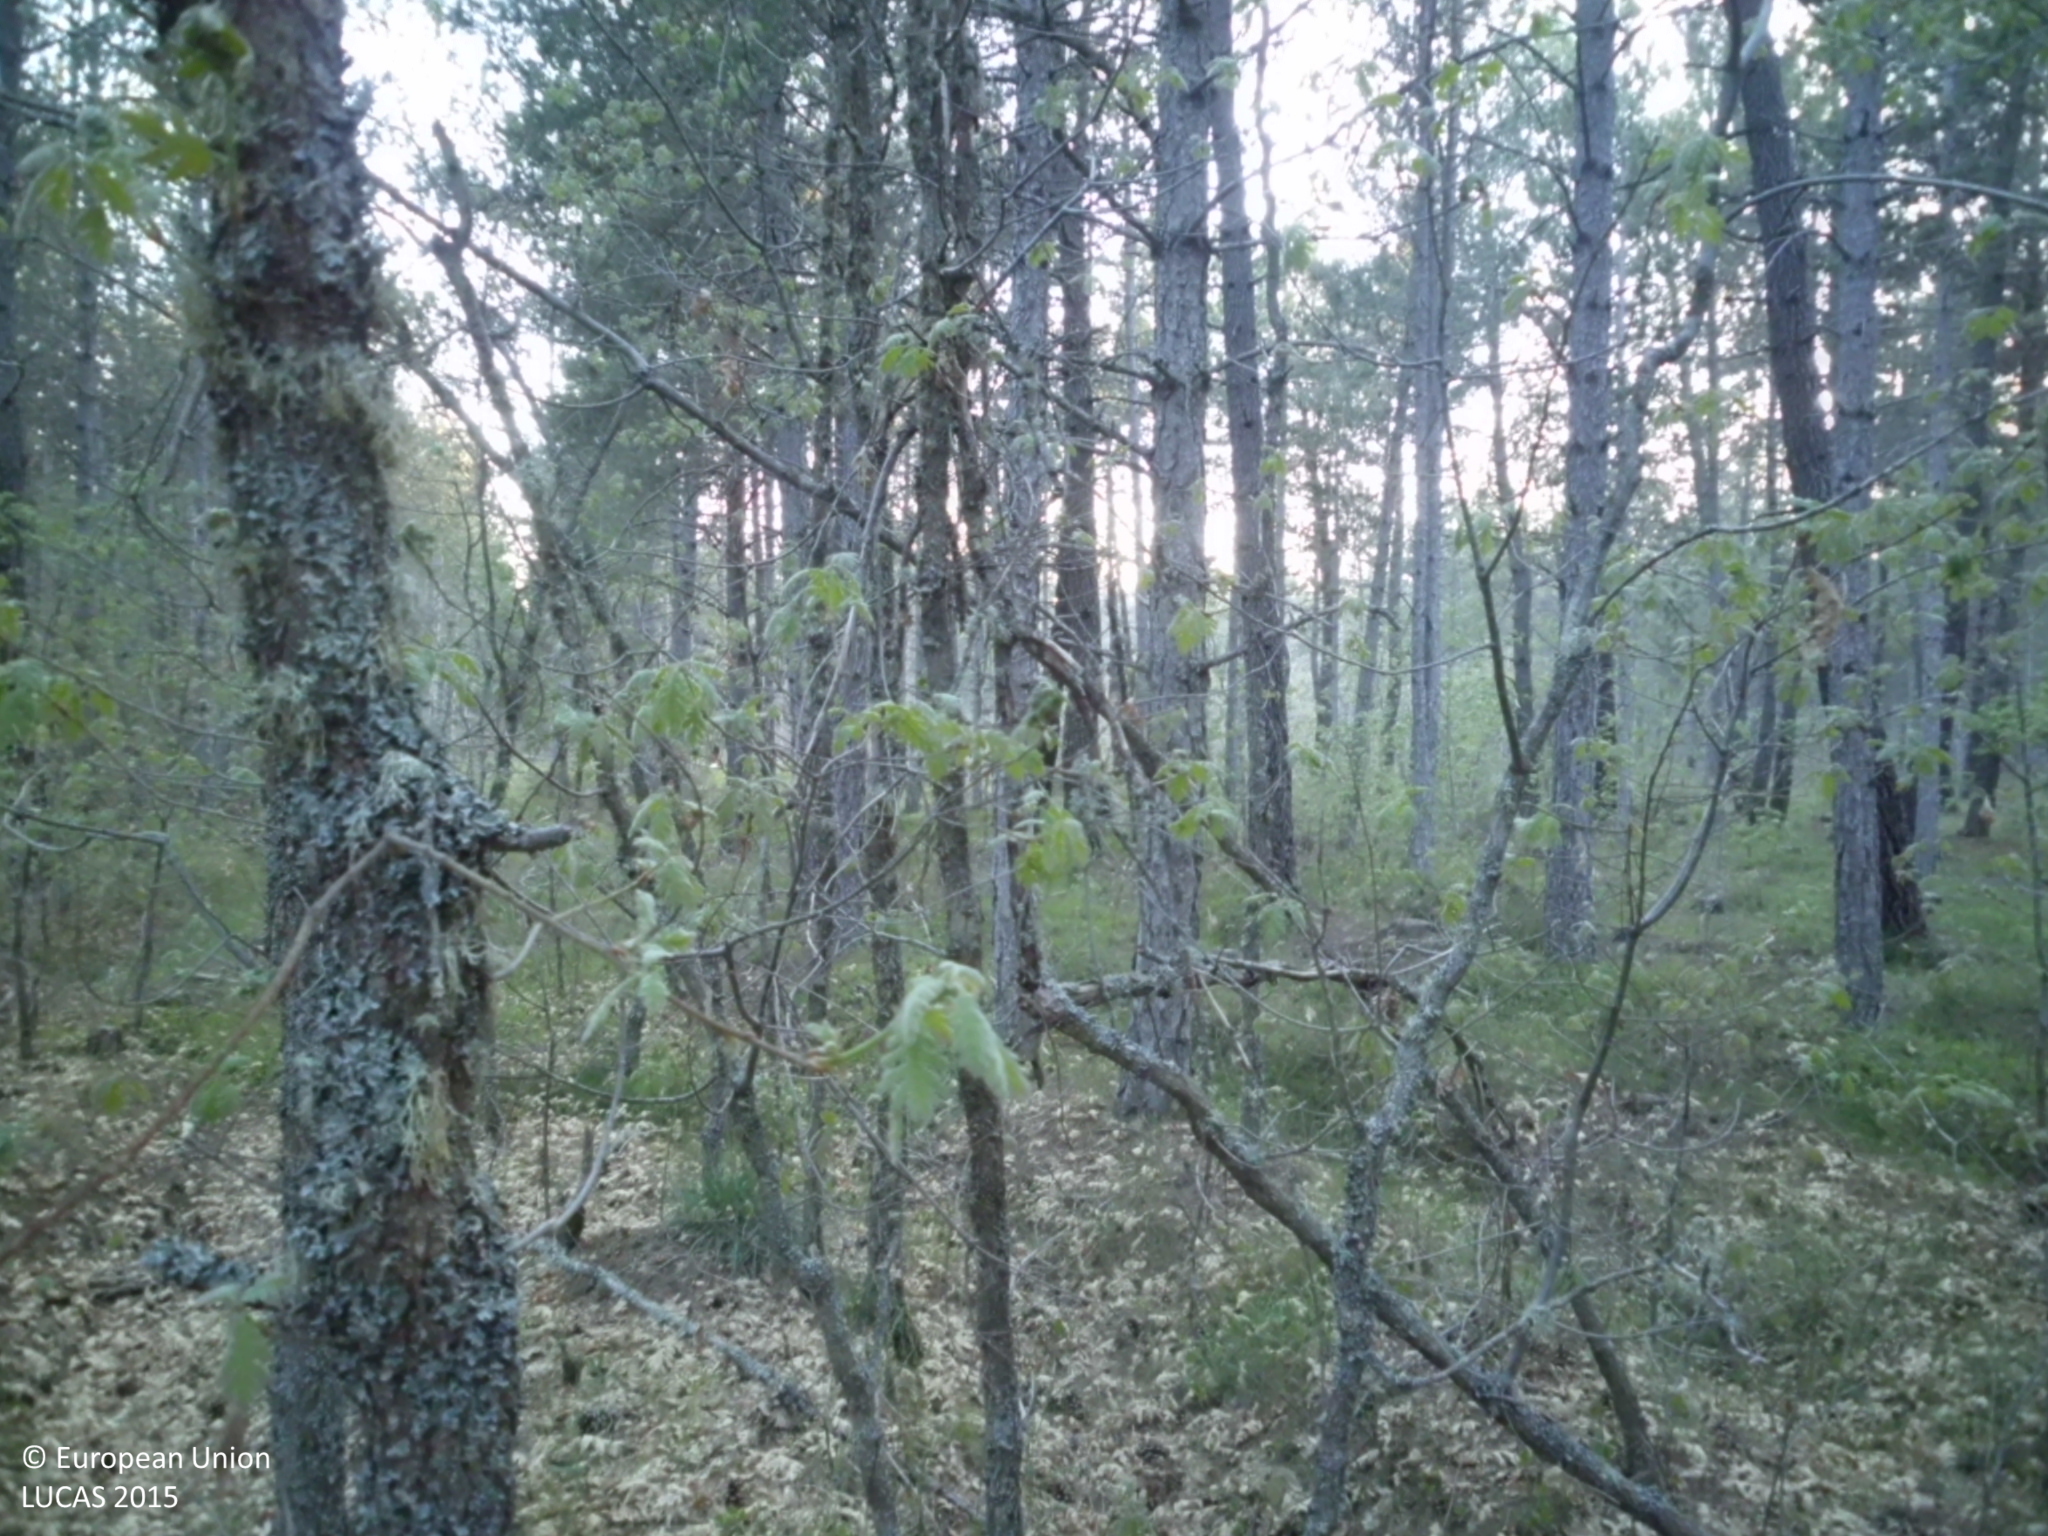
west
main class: Woodland
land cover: Pine dominated coniferous woodland
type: coniferous forest of the mediterranean region
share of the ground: > 75 %
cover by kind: coniferous forest trees 100 %
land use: Forestry
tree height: > 5 m
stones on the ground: > 50 %
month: May
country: ES
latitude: 42.6124
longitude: -4.8704
